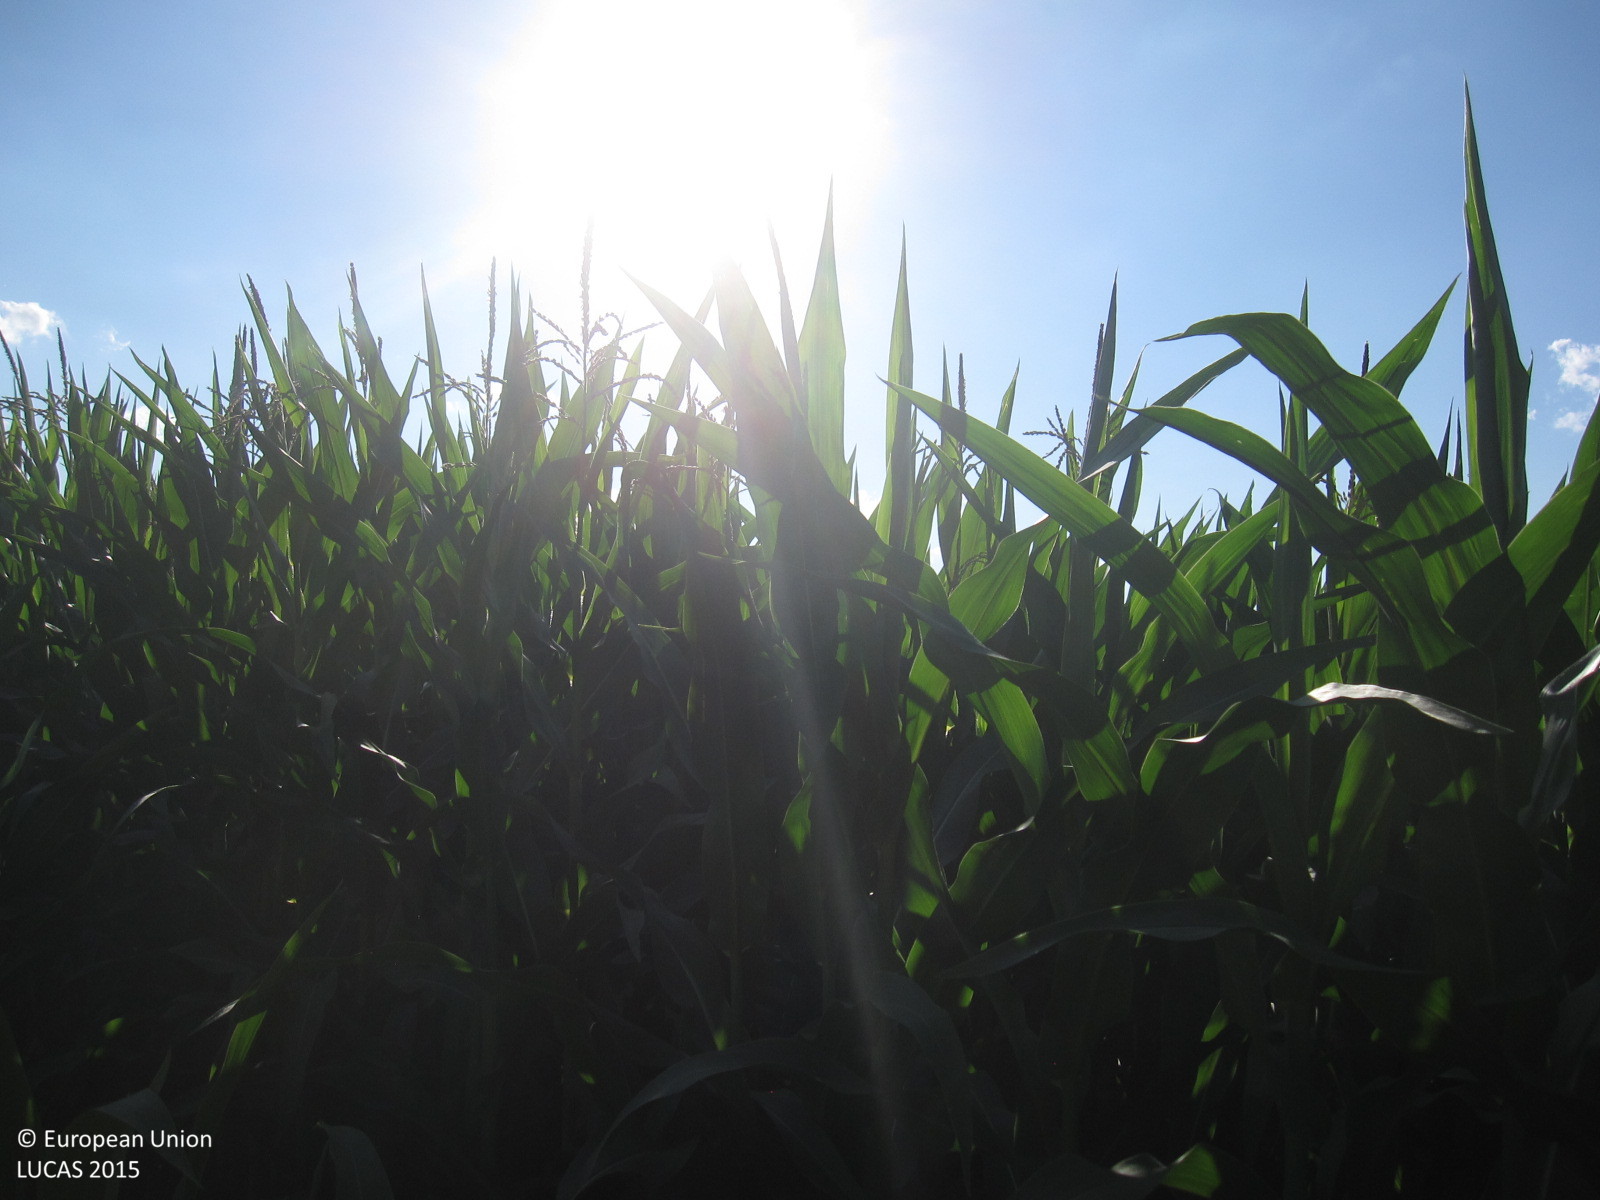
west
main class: Cropland
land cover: Maize
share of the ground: > 75 %
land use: Agriculture (excluding fallow land and kitchen gardens)
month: July
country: DE
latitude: 51.0088
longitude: 12.1803
